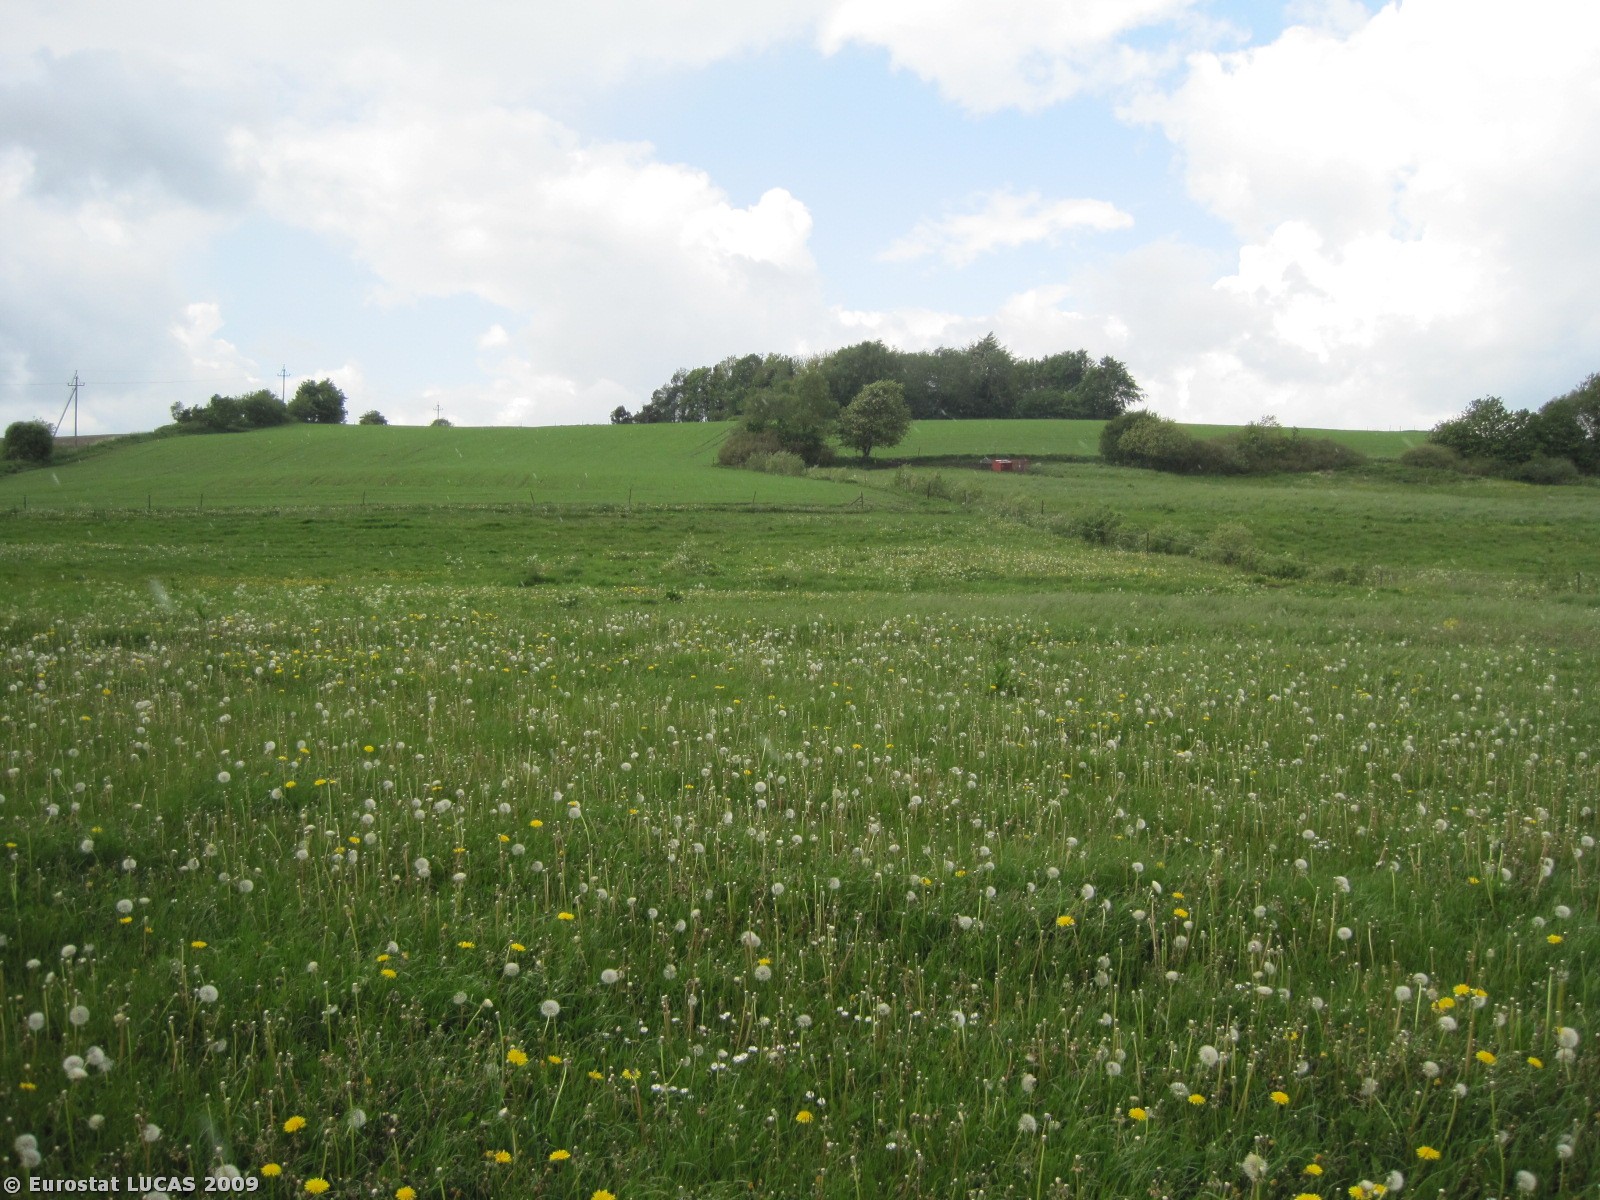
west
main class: Grassland
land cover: Grassland without tree/shrub cover
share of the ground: > 75 %
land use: Agriculture (excluding fallow land and kitchen gardens)
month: May
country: DK
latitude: 56.7268
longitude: 9.7552
